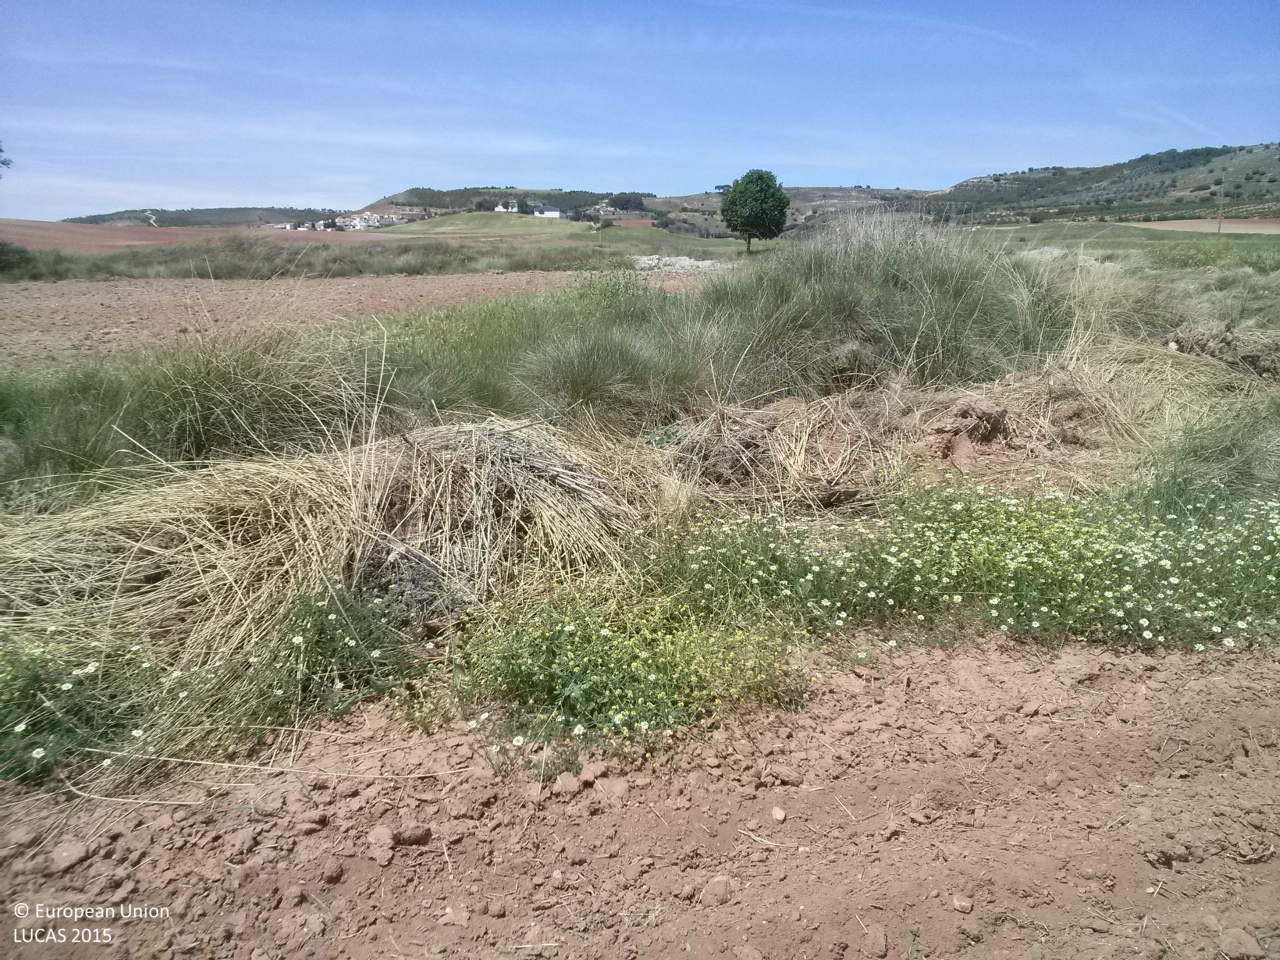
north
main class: Cropland
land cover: Sunflower
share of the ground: < 10 %
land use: Agriculture (excluding fallow land and kitchen gardens)
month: May
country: ES
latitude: 40.0432
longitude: -2.6908
